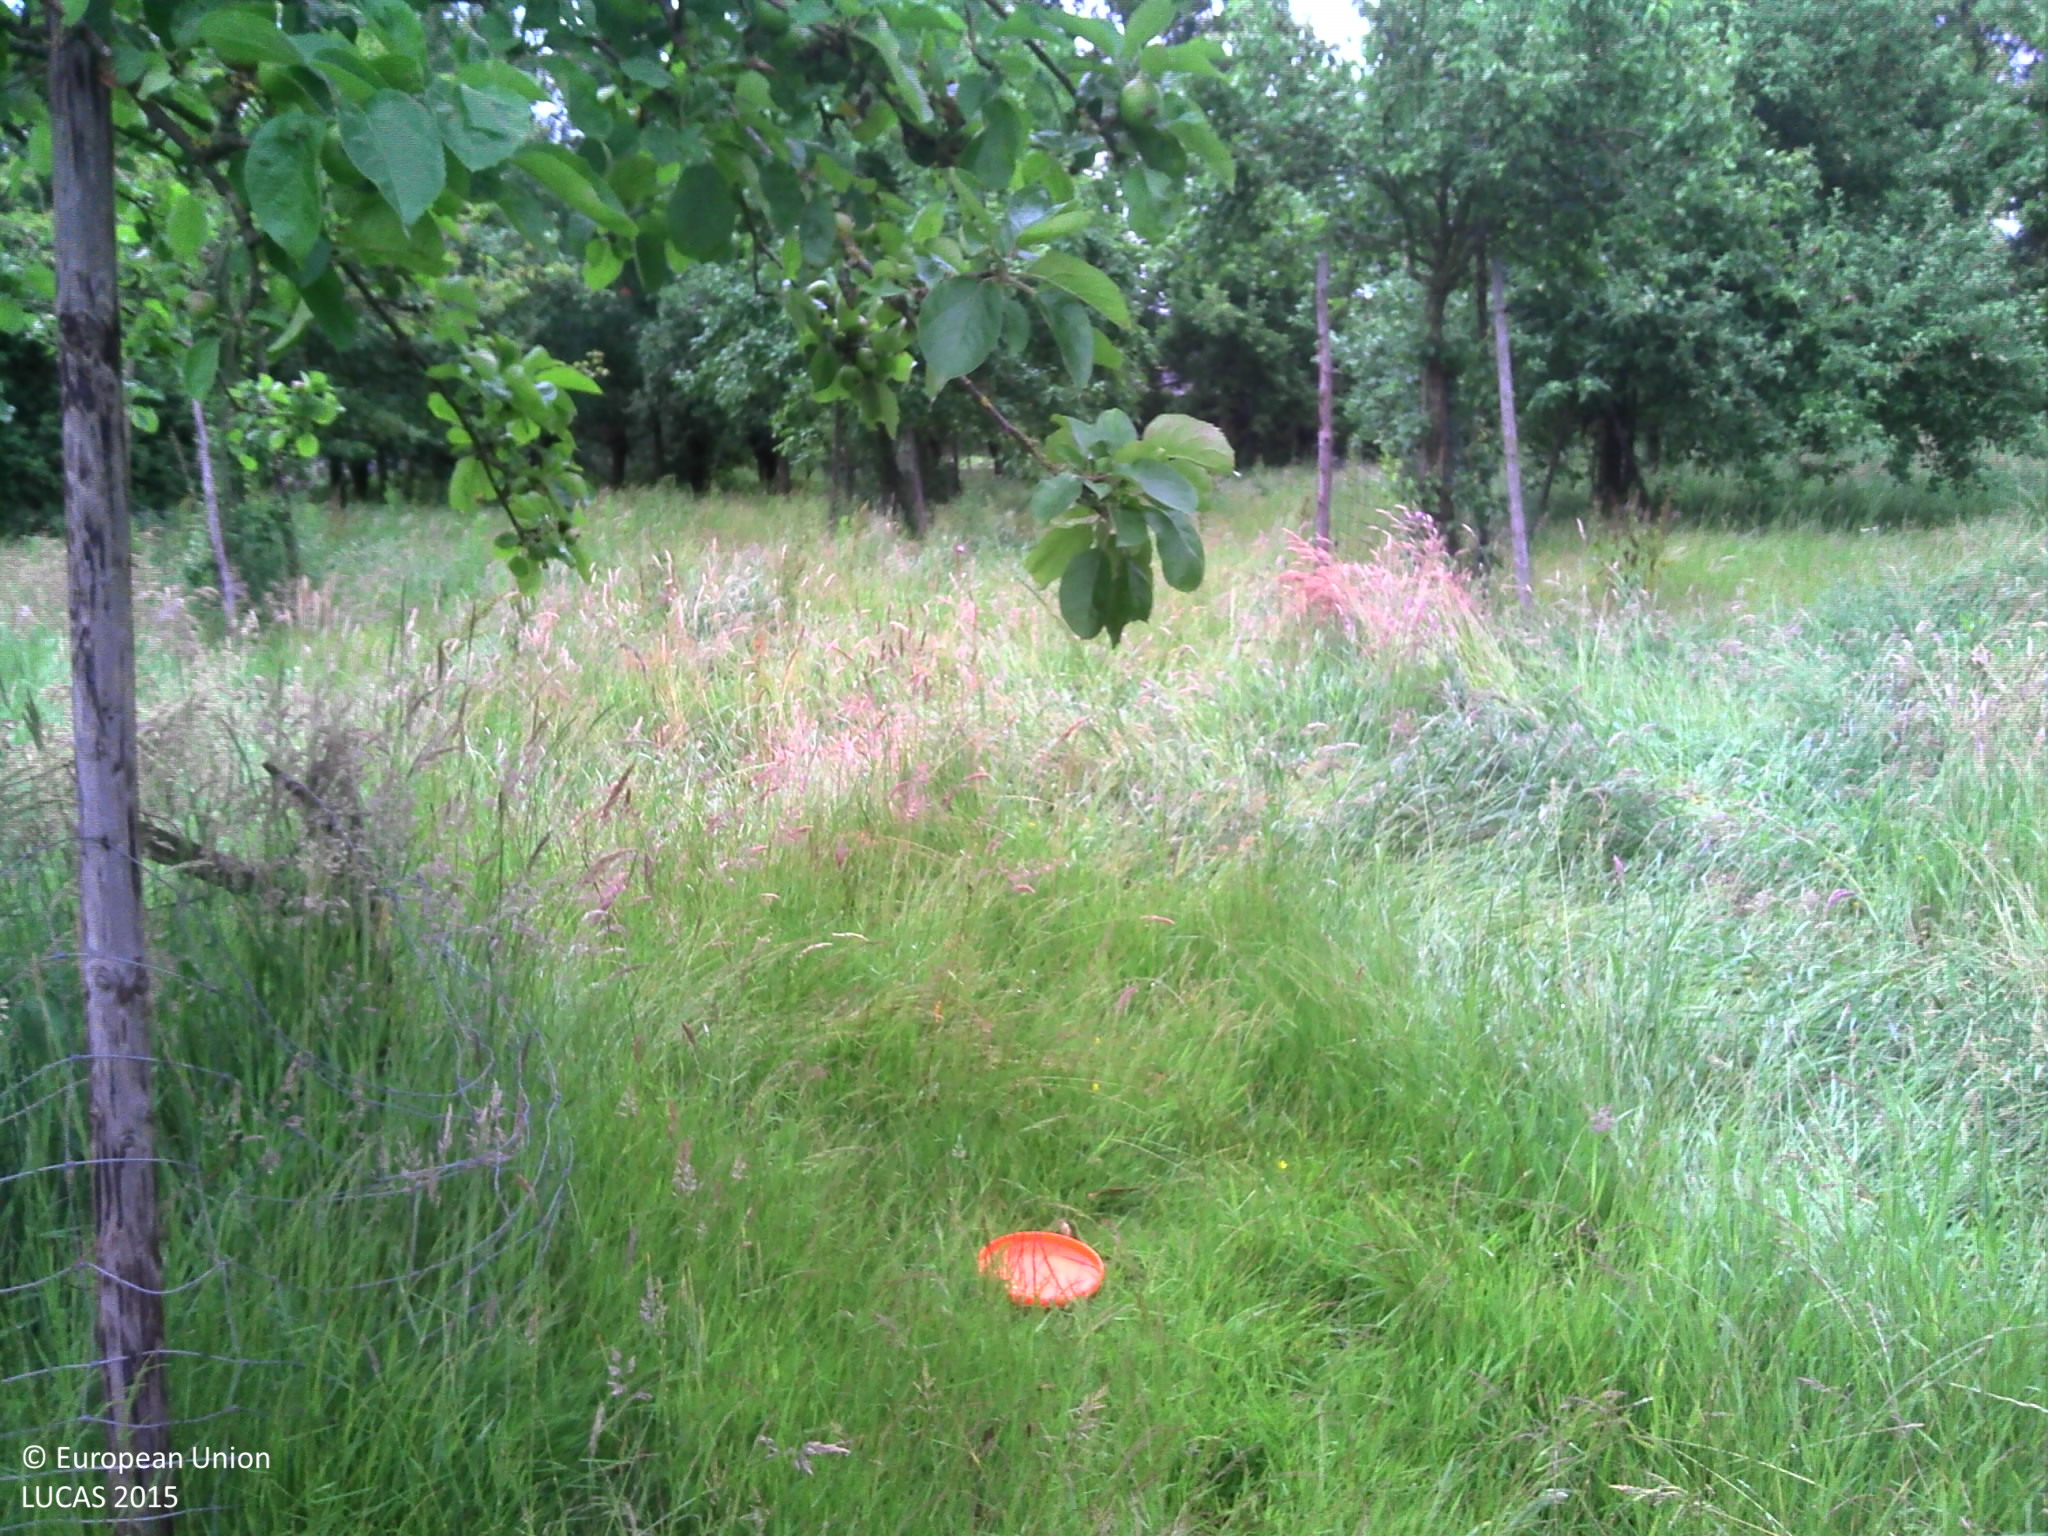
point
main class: Cropland
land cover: Apple fruit
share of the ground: 25 - 50 %
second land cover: Grassland without tree/shrub cover
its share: > 75 %
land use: Agriculture (excluding fallow land and kitchen gardens)
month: June
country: BE
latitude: 51.1056
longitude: 3.9526
